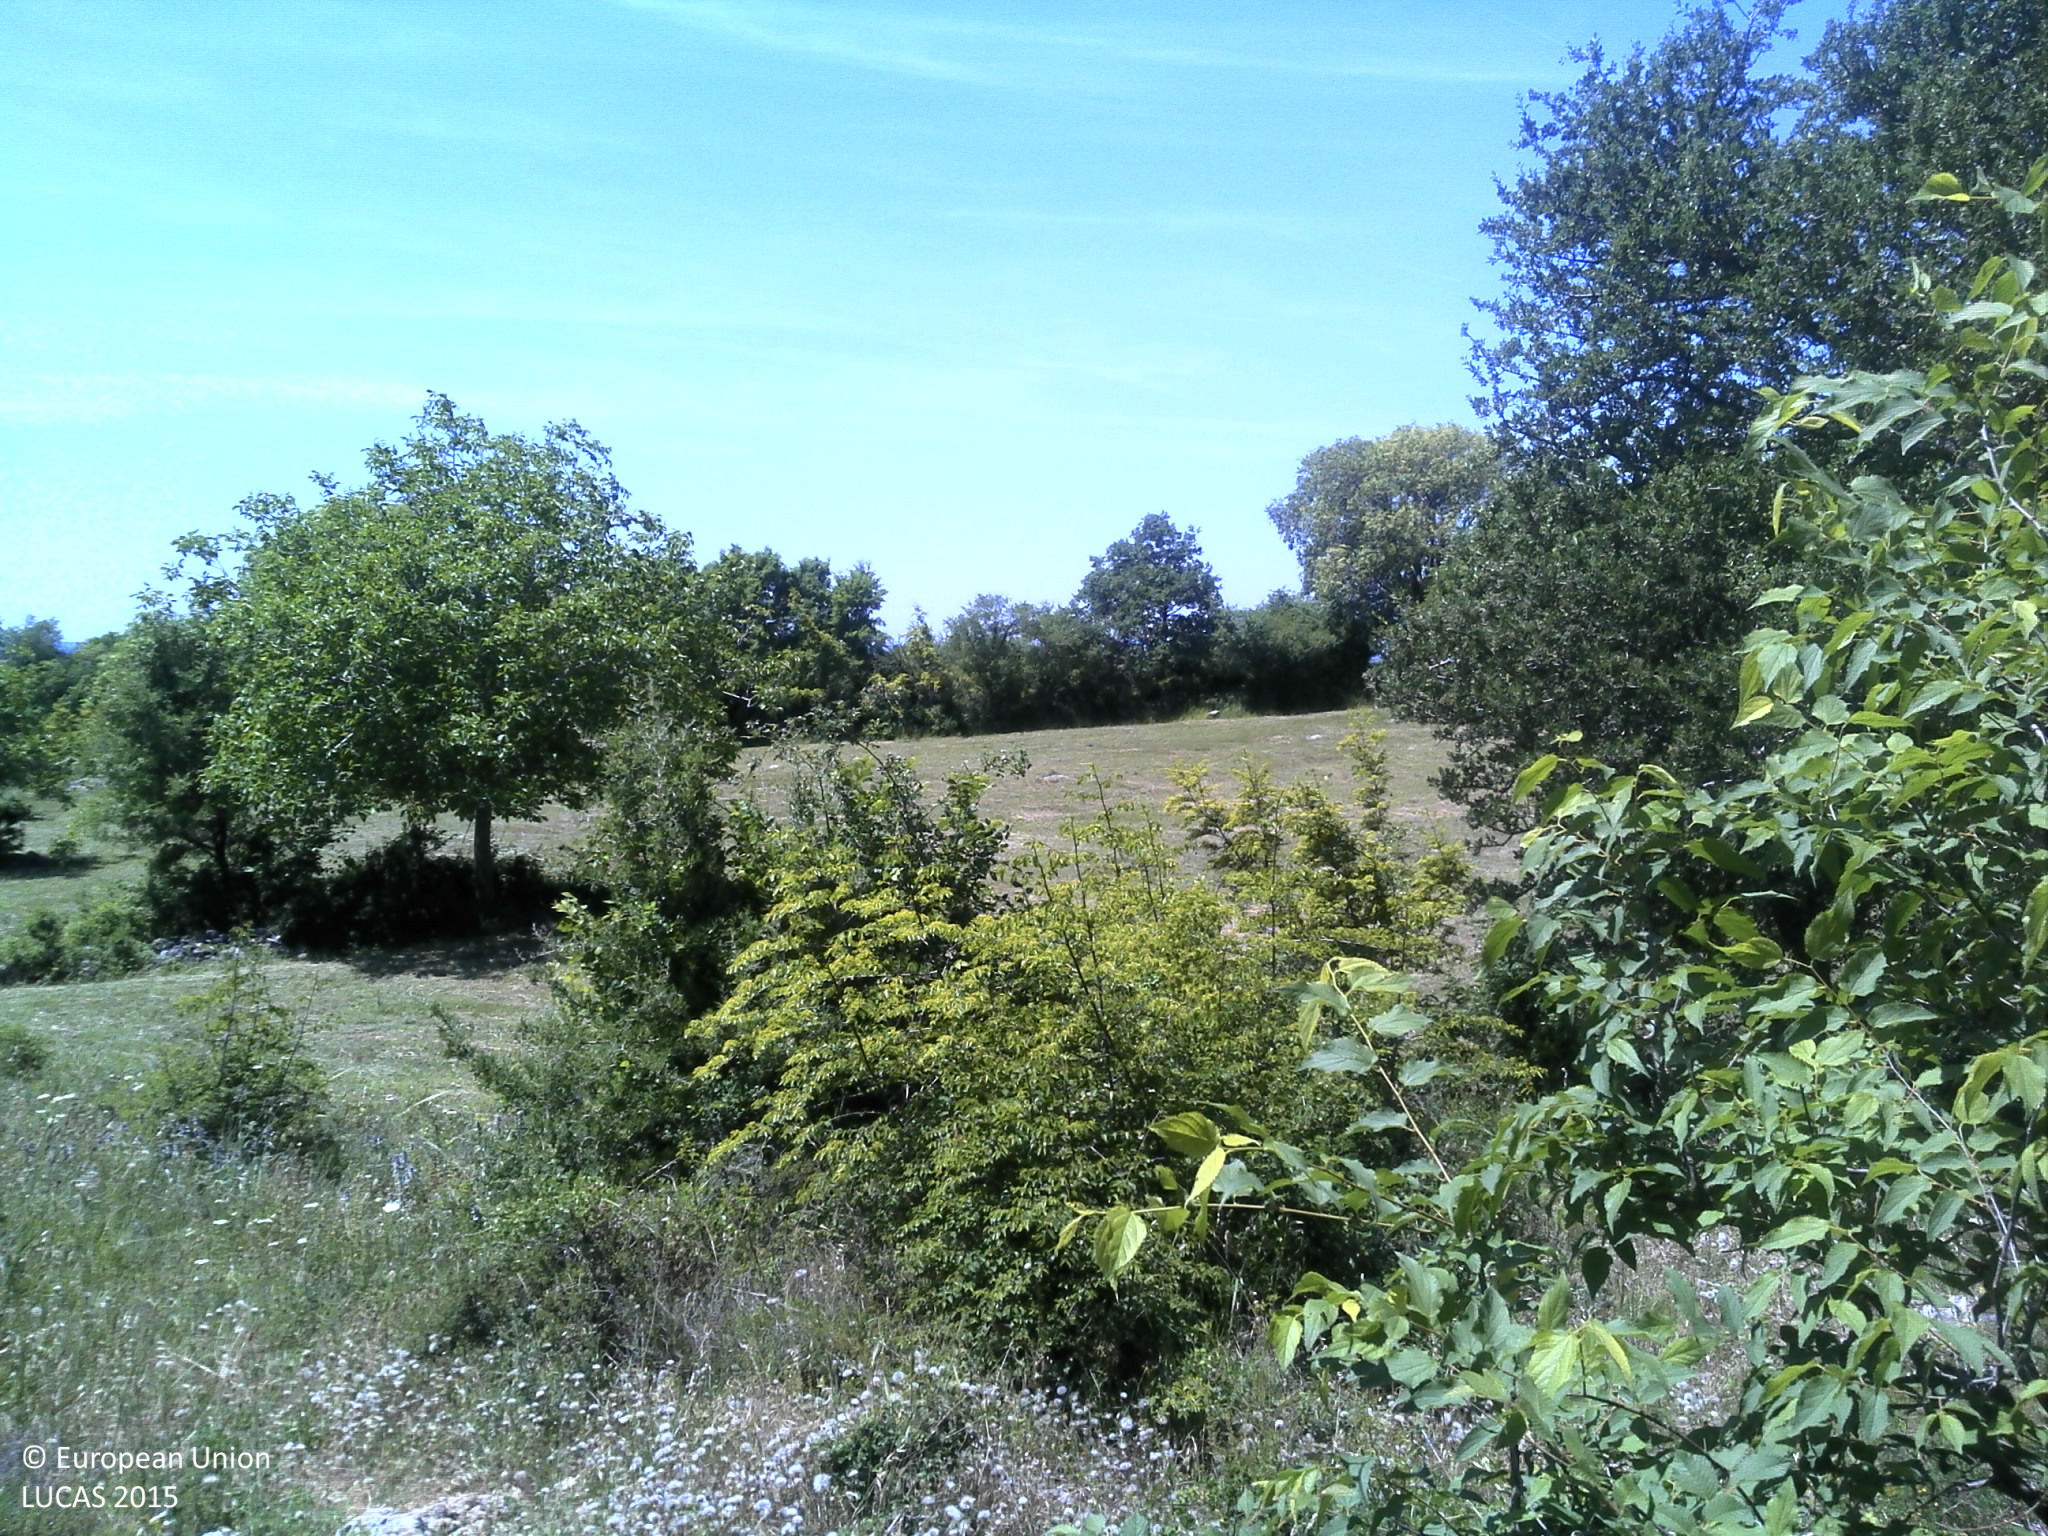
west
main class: Woodland
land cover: Broadleaved woodland
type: thermophilous deciduous forest
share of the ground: 25 - 50 %
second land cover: Grassland without tree/shrub cover
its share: 50 - 75 %
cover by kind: herbaceous plants 50 %, broadleaved forest trees 30 %, shrubs 20 %
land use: Forestry
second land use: Agriculture (excluding fallow land and kitchen gardens)
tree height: > 5 m
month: May
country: HR
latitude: 43.9160
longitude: 16.1315
